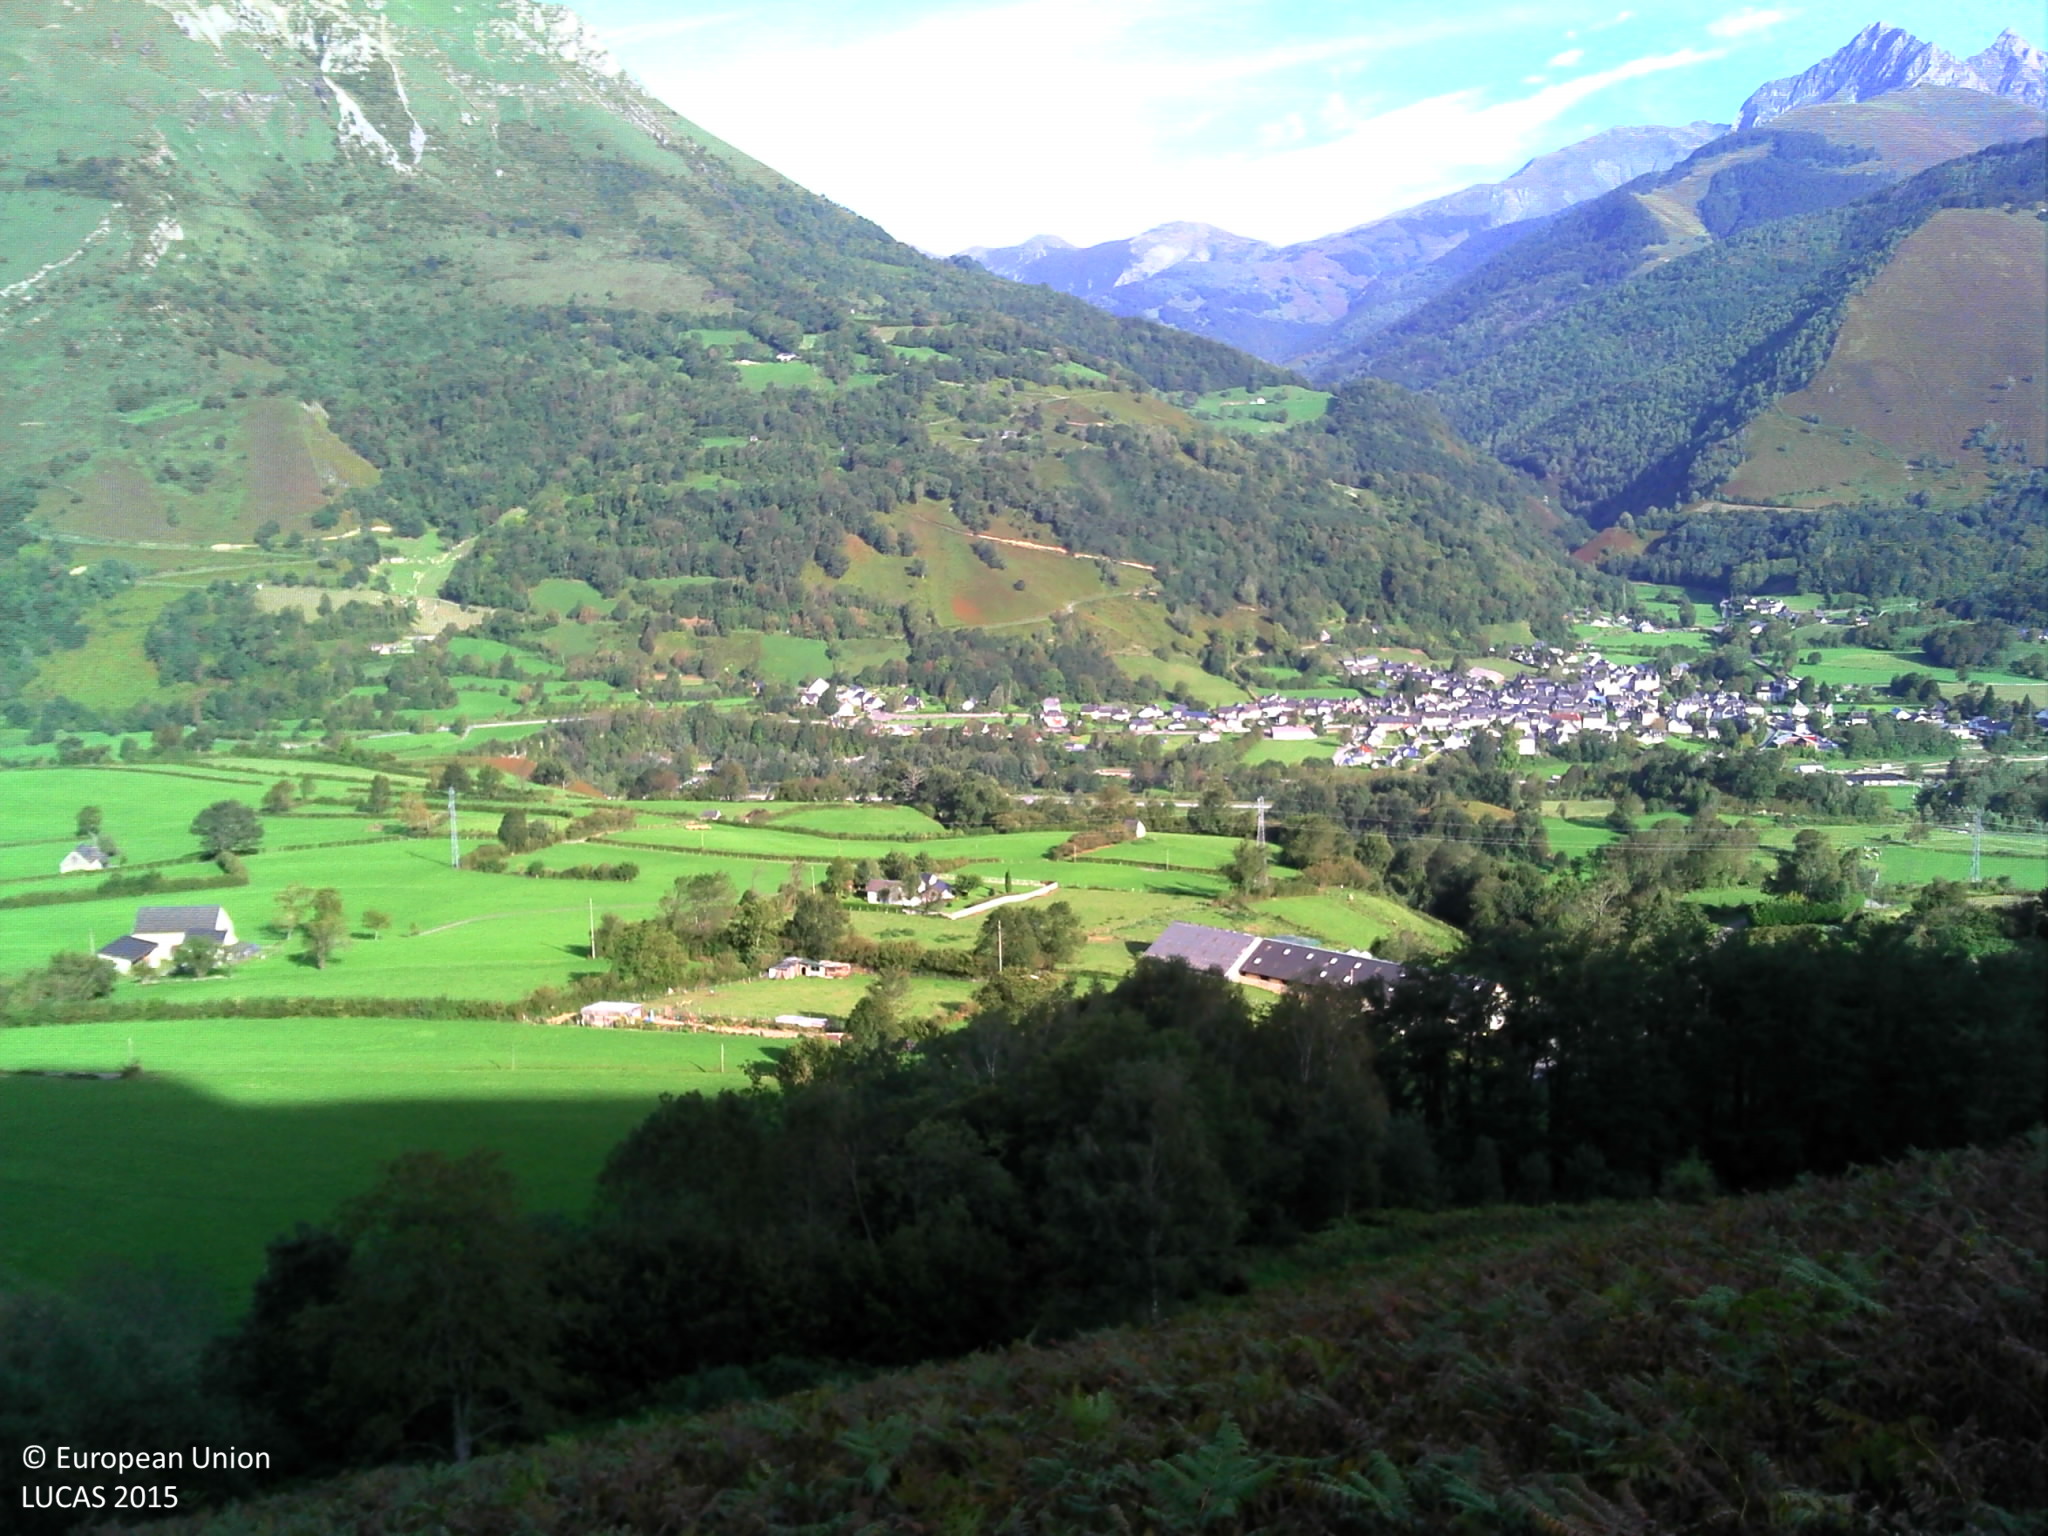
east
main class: Grassland
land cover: Grassland without tree/shrub cover
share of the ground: > 75 %
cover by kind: herbaceous plants 95 %, shrubs 5 %
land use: Agriculture (excluding fallow land and kitchen gardens)
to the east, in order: Grassland without tree/shrub cover; Tracks; Shrubland without tree cover; Broadleaved woodland; Rivers and streams; Broadleaved woodland; Electric lines; Grassland without tree/shrub cover; Managed hedges; Electric lines; Ditches and canals; Paved roads, cycling and walking lanes; Grassland without tree/shrub cover; Grass margins; Tracks; Managed hedges
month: September
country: FR
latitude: 43.0041
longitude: -0.6181
